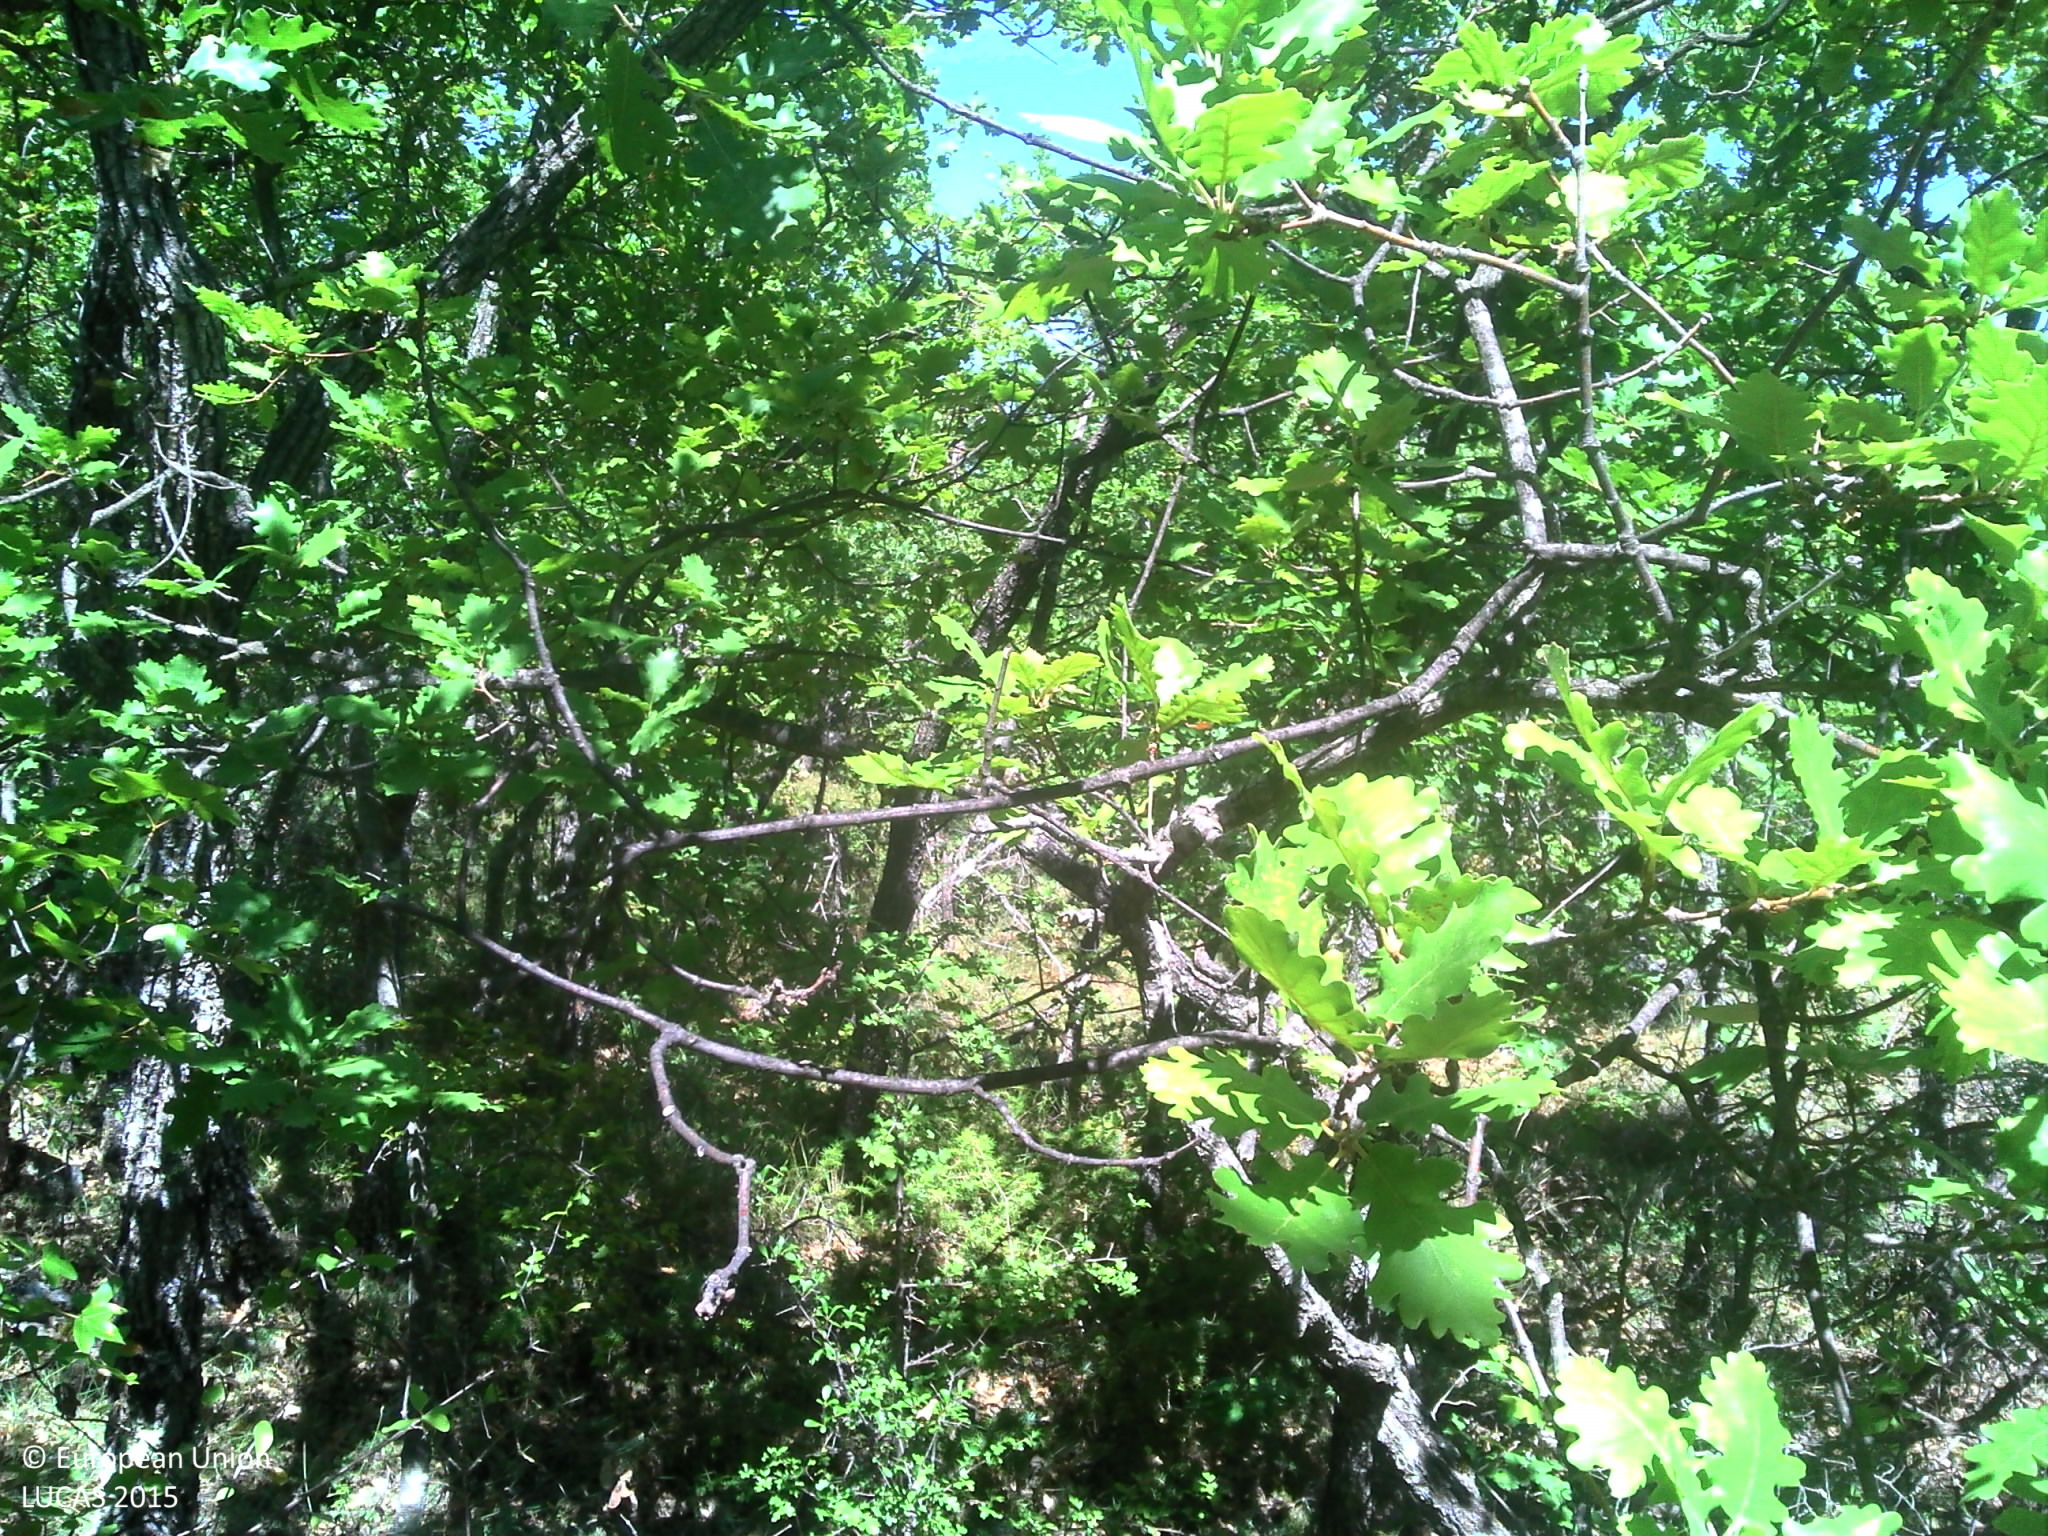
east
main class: Woodland
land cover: Broadleaved woodland
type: thermophilous deciduous forest
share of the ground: 50 - 75 %
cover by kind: broadleaved forest trees 70 %, shrubs 10 %, herbaceous plants 10 %, consolidated bare surface 10 %
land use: Forestry
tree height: > 5 m
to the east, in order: Broadleaved woodland; Electric lines; Broadleaved woodland
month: July
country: FR
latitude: 43.9485
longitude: 5.5602
